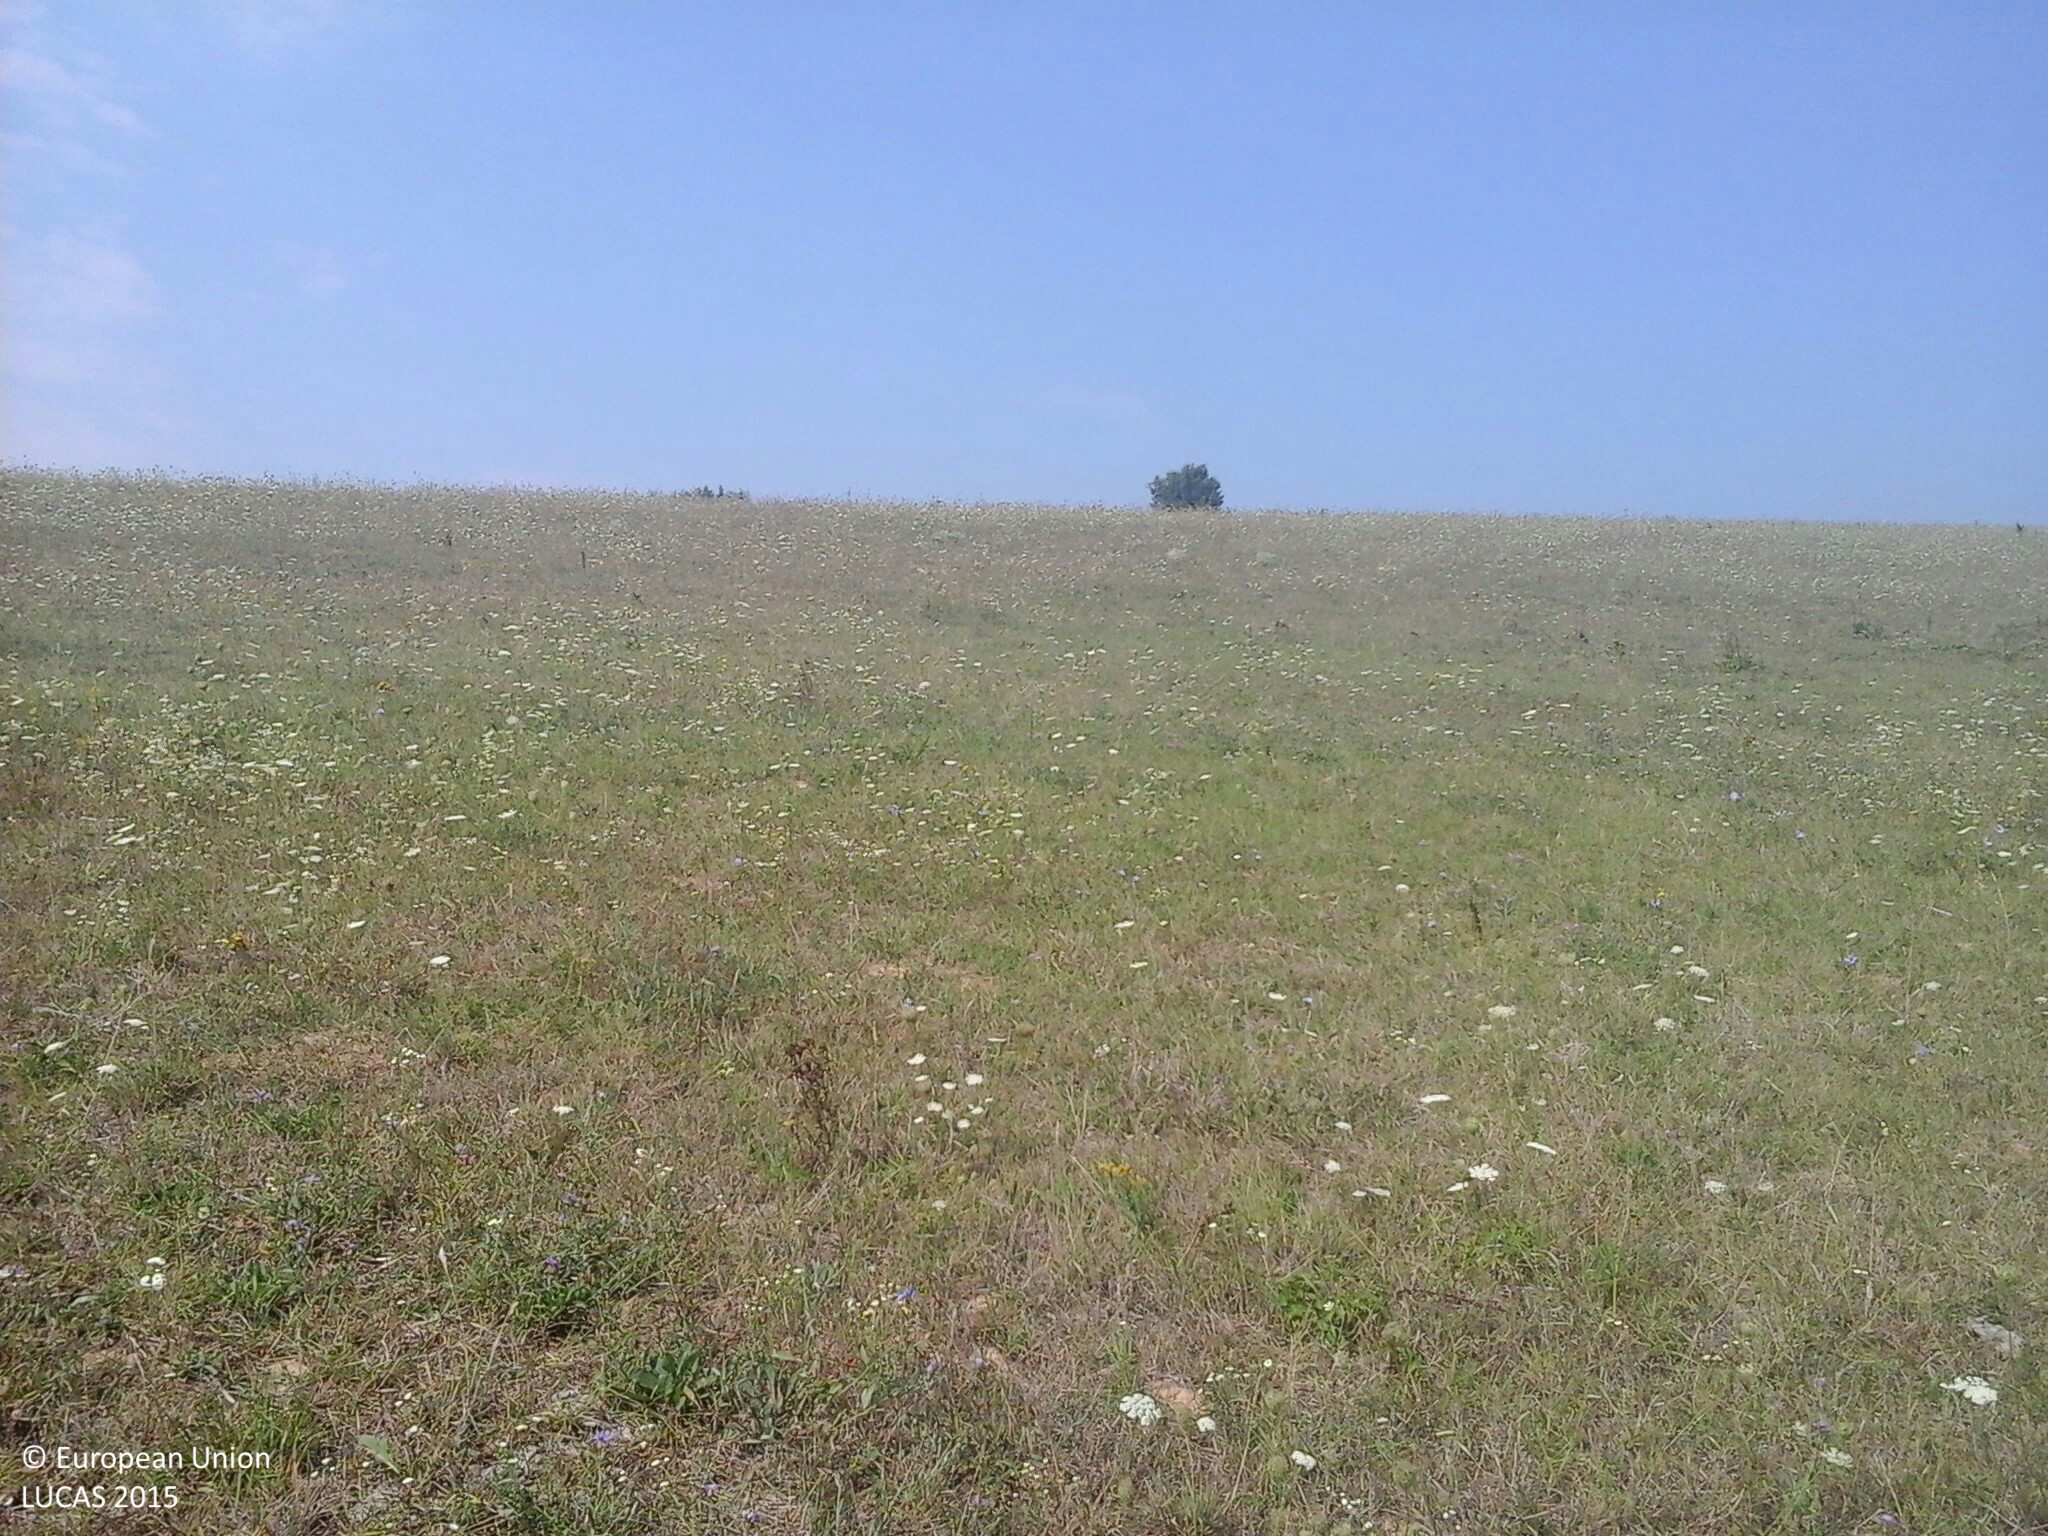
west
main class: Grassland
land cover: Grassland without tree/shrub cover
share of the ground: > 75 %
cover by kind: herbaceous plants 100 %
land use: Agriculture (excluding fallow land and kitchen gardens)
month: August
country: HU
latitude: 48.4575
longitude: 20.7609
